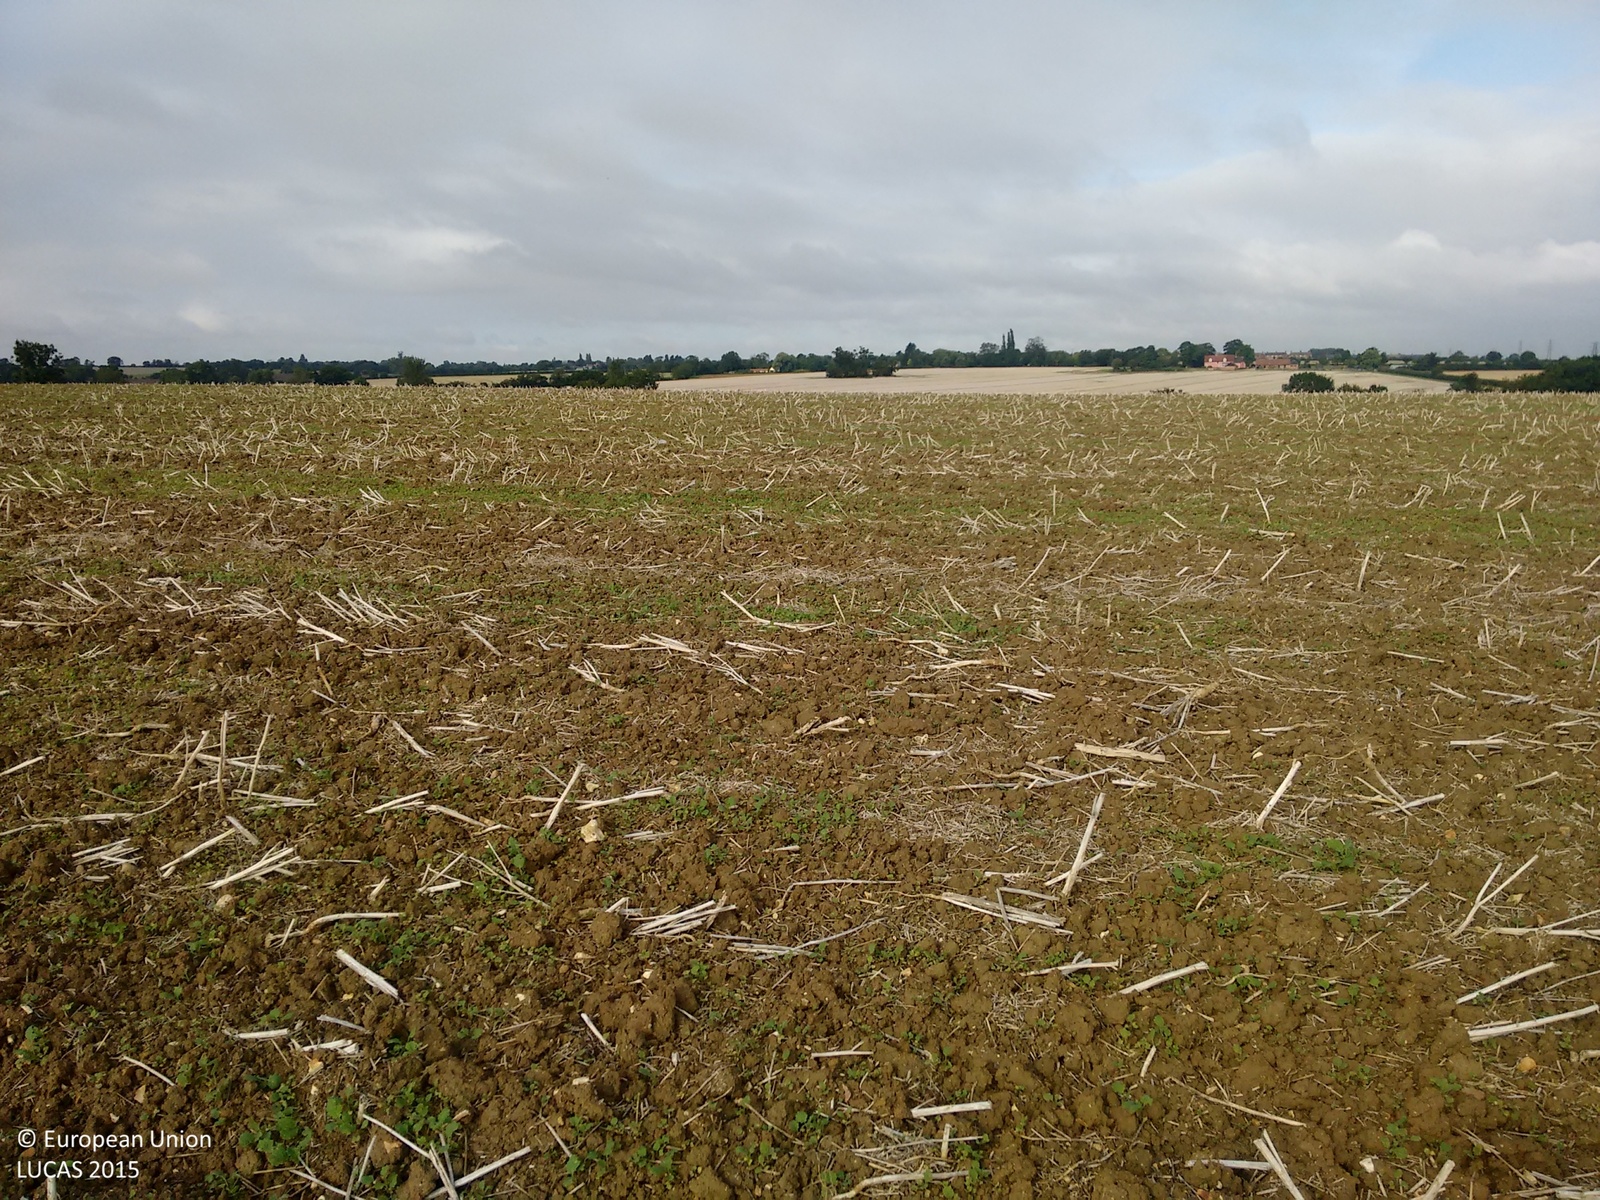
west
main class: Cropland
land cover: Rape and turnip rape
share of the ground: 25 - 50 %
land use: Agriculture (excluding fallow land and kitchen gardens)
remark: Harvested field
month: September
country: GB
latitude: 52.1607
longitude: 0.9864
